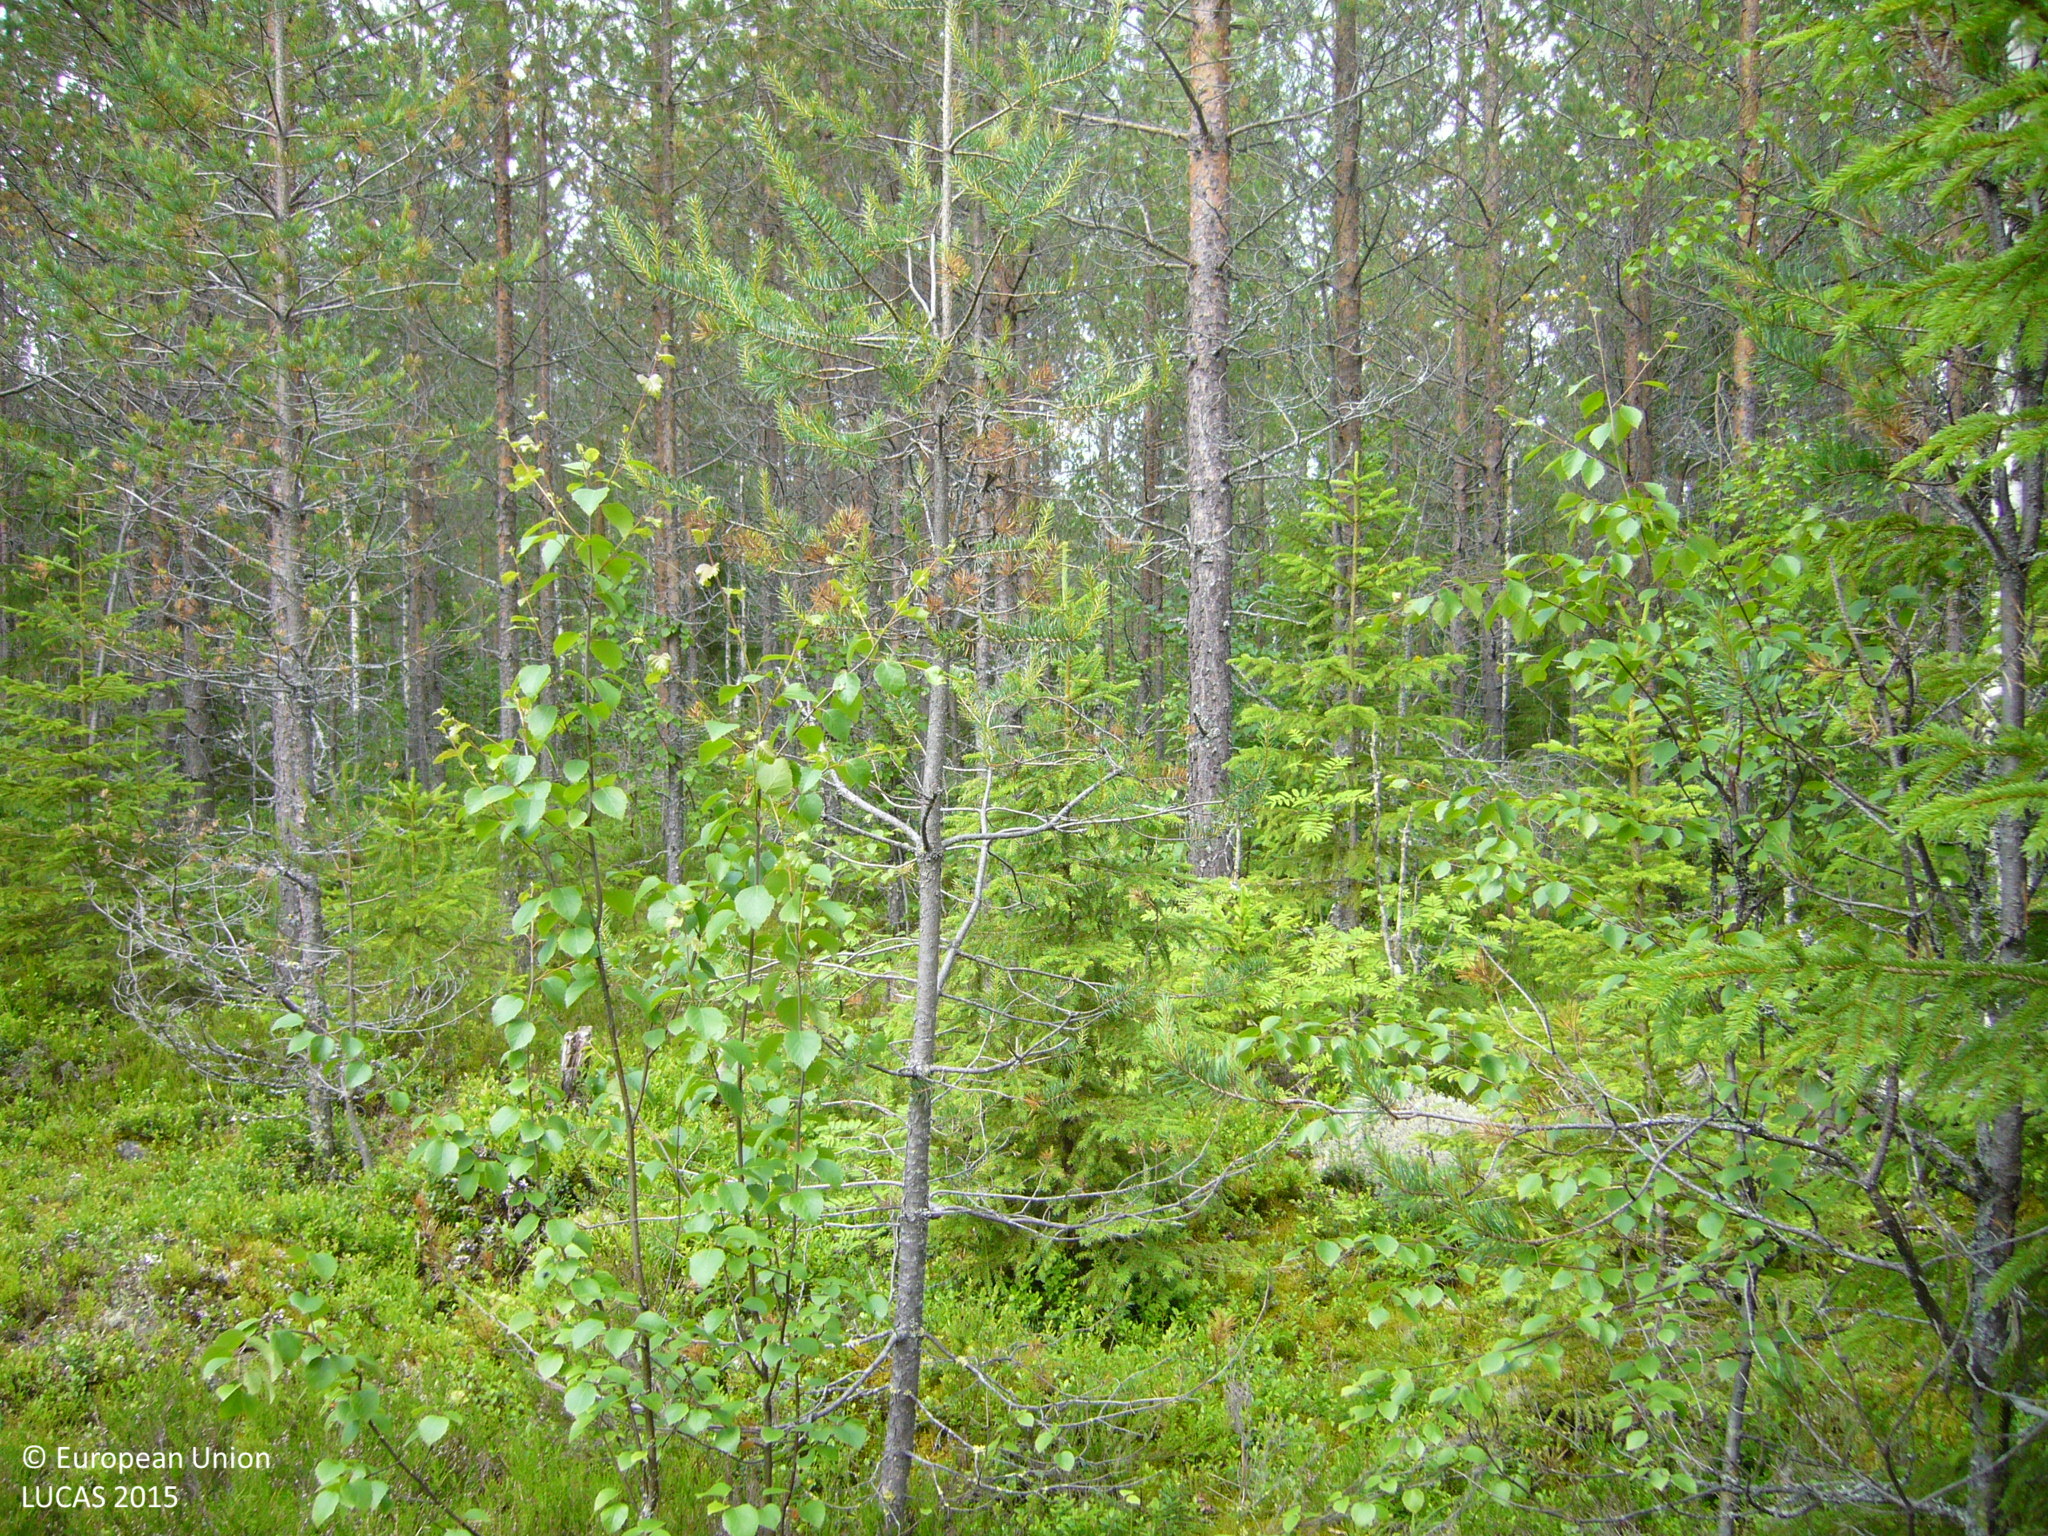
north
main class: Woodland
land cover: Pine dominated coniferous woodland
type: boreal forest
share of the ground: 50 - 75 %
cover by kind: coniferous forest trees 60 %, shrubs 40 %
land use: Forestry
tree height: > 5 m
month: July
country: FI
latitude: 63.5616
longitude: 25.6248
